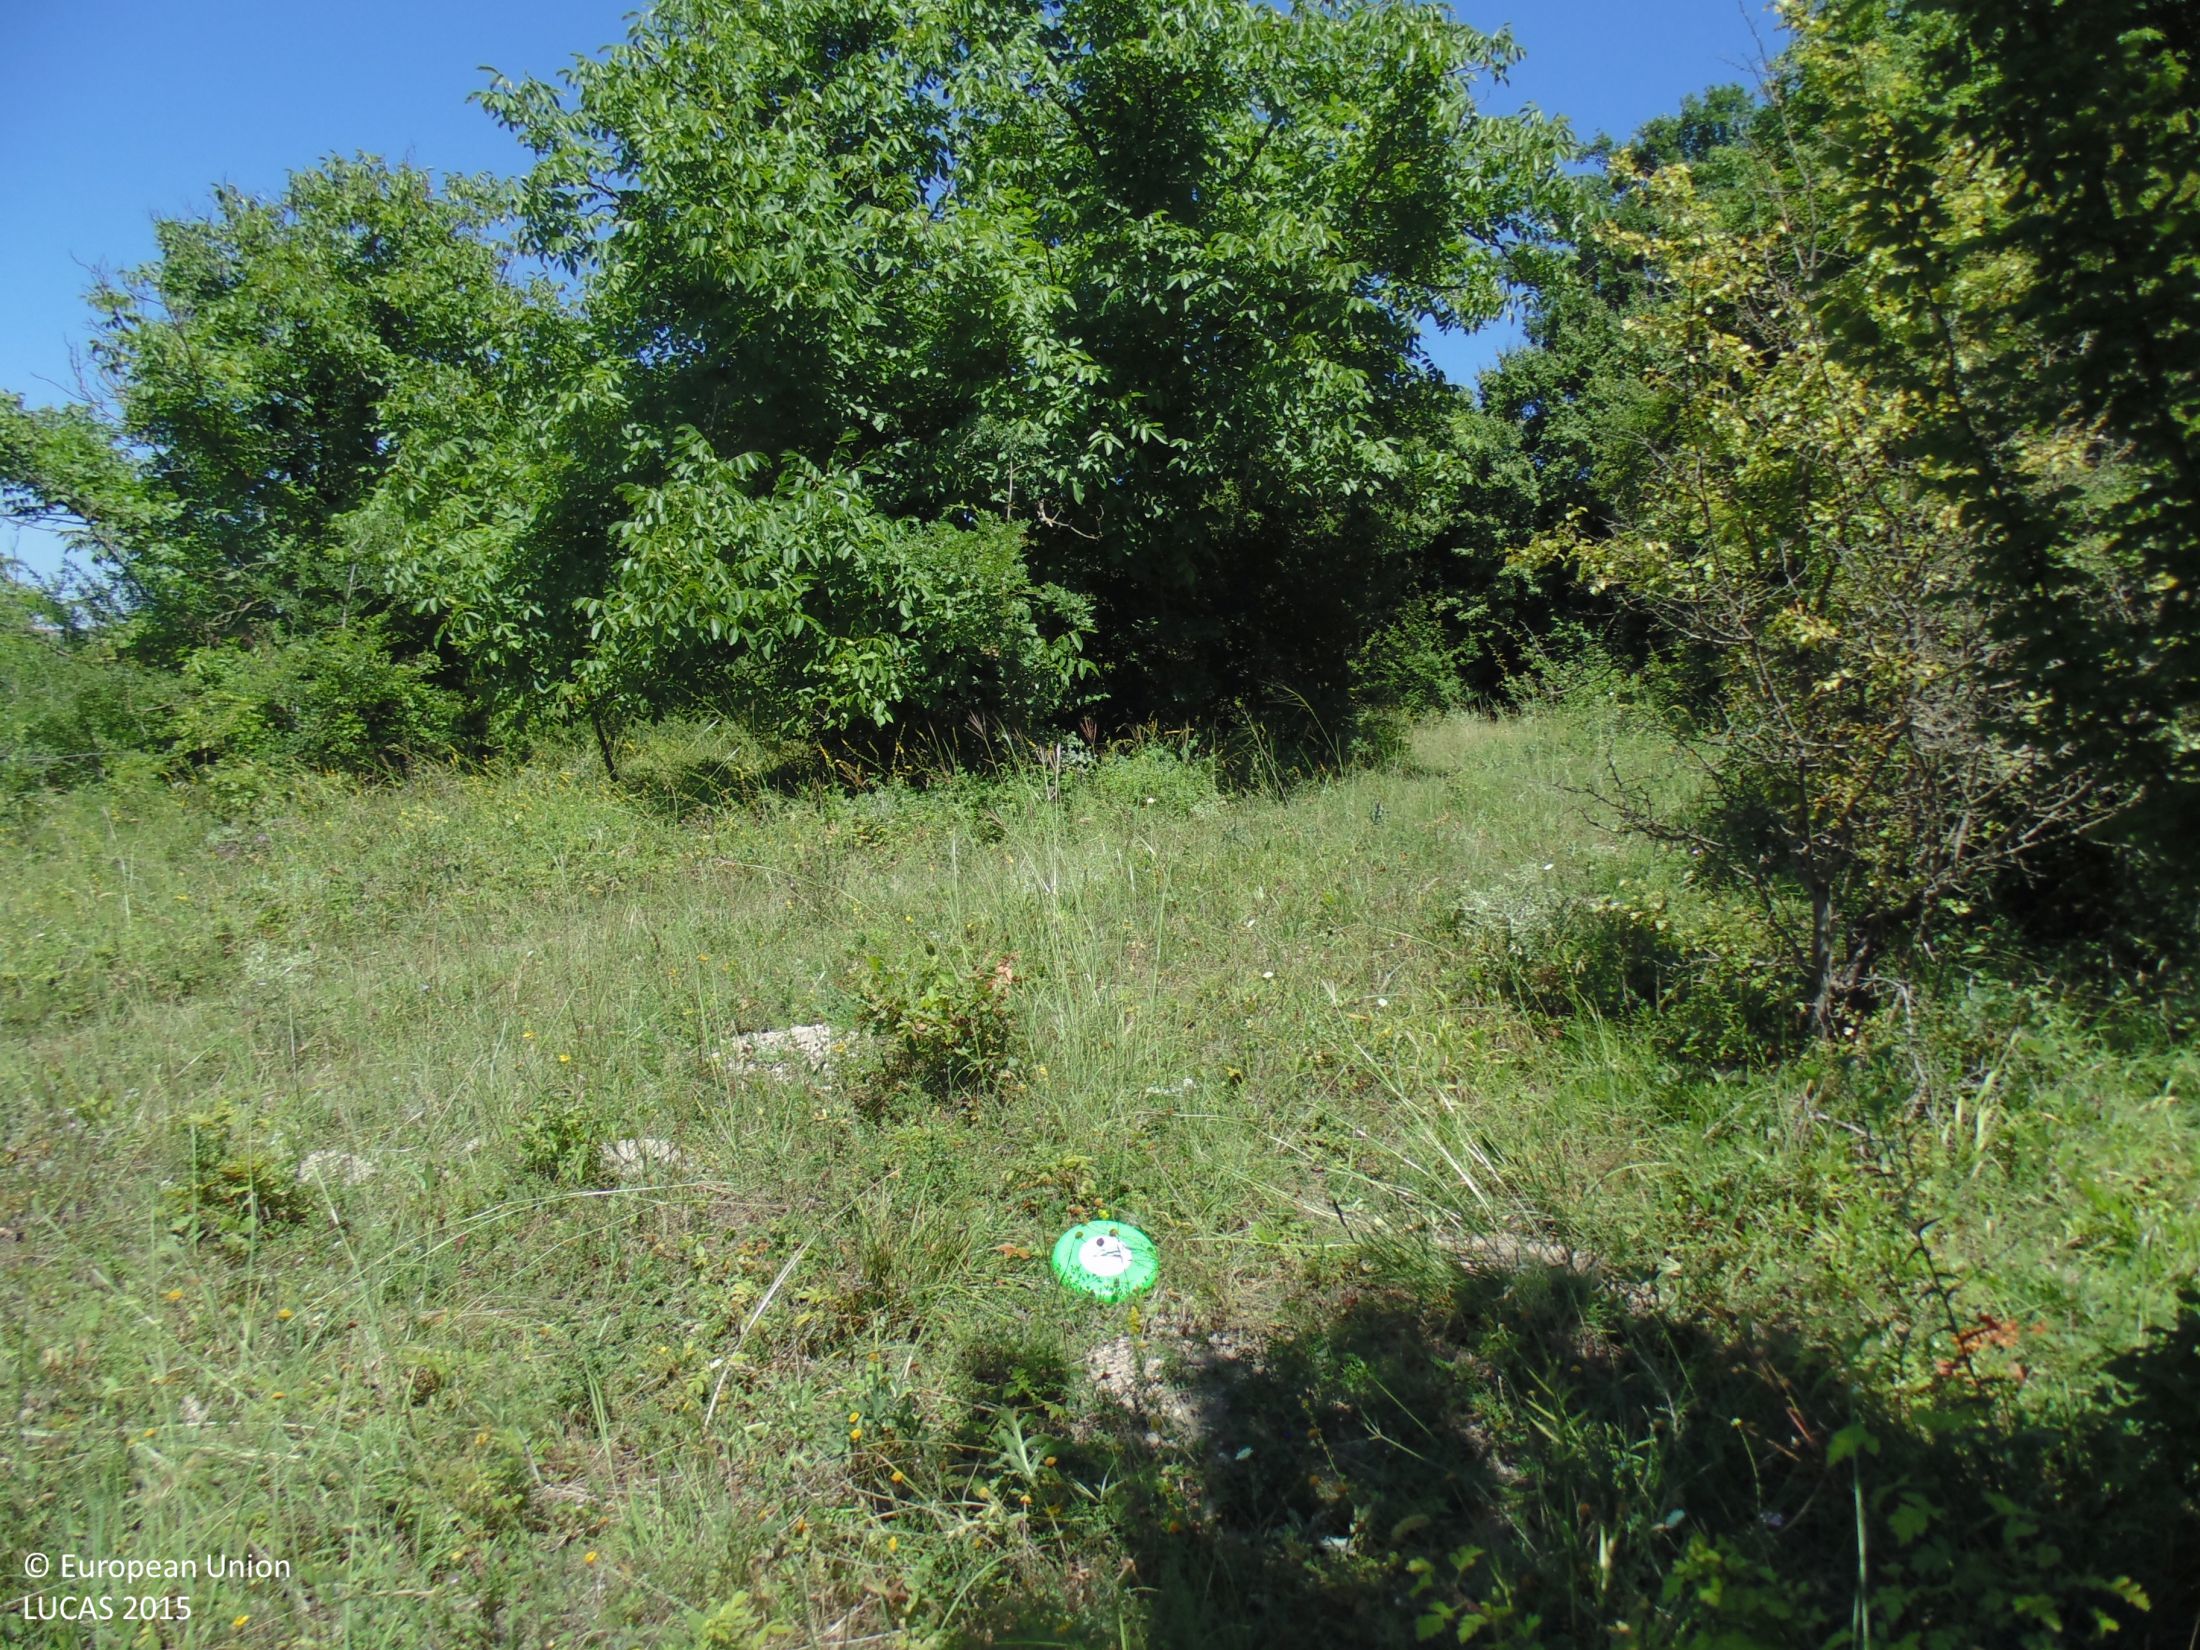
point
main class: Woodland
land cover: Broadleaved woodland
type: mesophytic deciduous forest
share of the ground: > 75 %
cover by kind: broadleaved forest trees 80 %, shrubs 15 %, consolidated bare surface 5 %
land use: Forestry
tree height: > 5 m
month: July
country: BG
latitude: 43.3953
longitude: 28.0603
